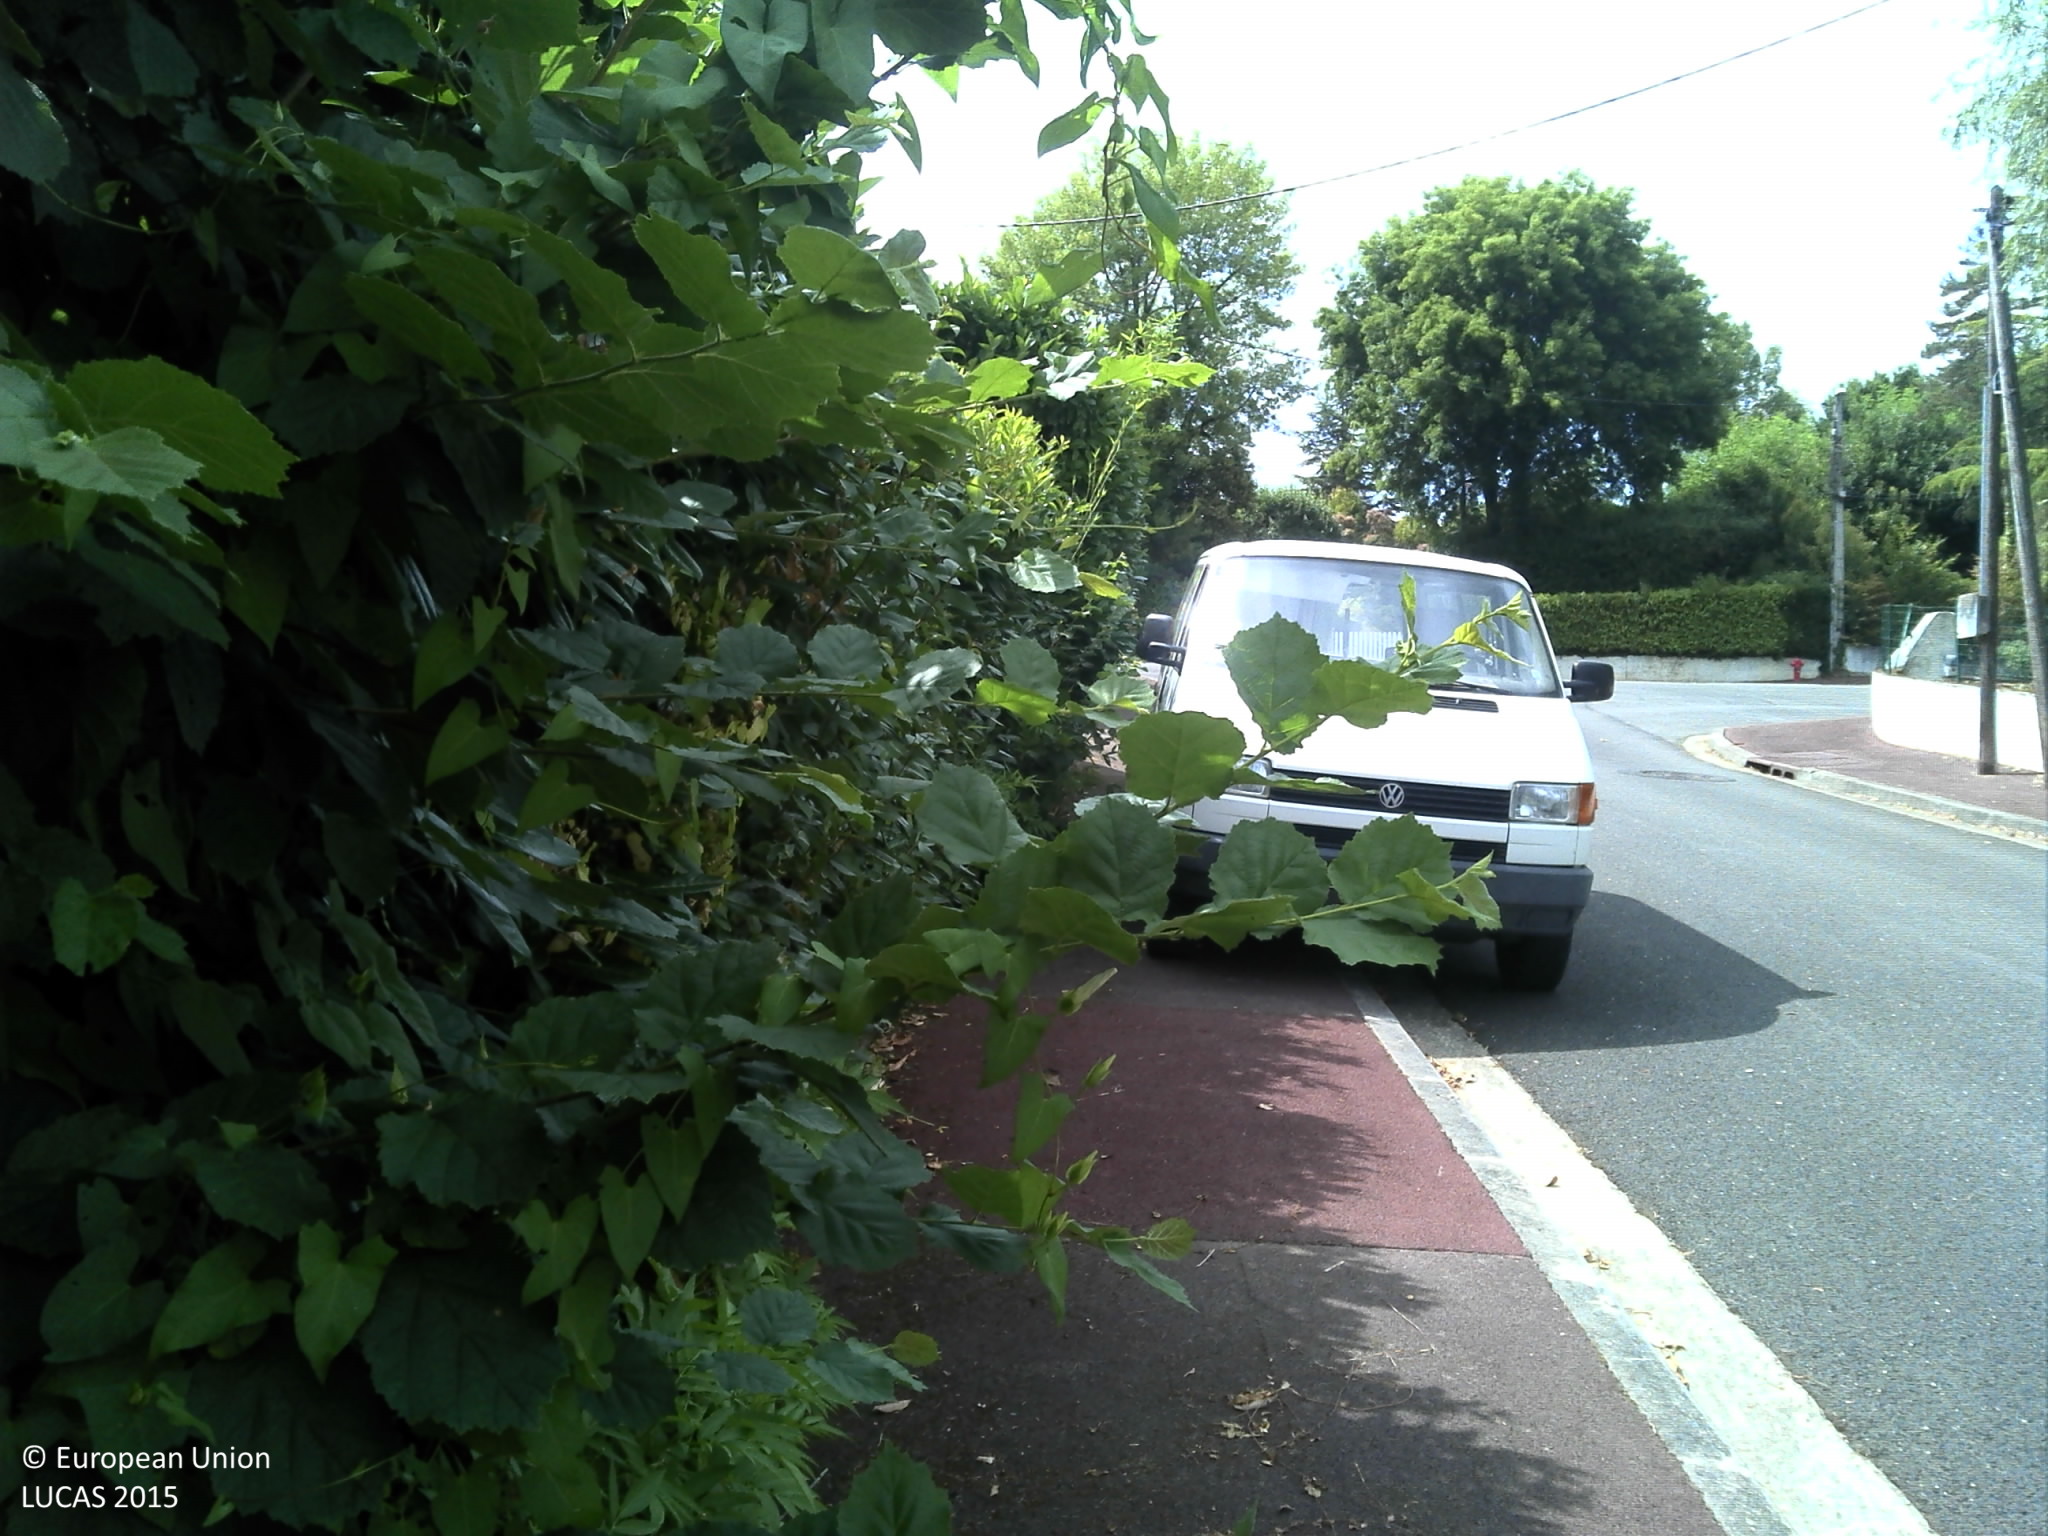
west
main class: Grassland
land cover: Grassland with sparse tree/shrub cover
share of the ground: > 75 %
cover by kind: herbaceous plants 85 %, unconsolidated bare surface 10 %, broadleaved forest trees 5 %
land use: Residential
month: July
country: FR
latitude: 44.8158
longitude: -0.5007
